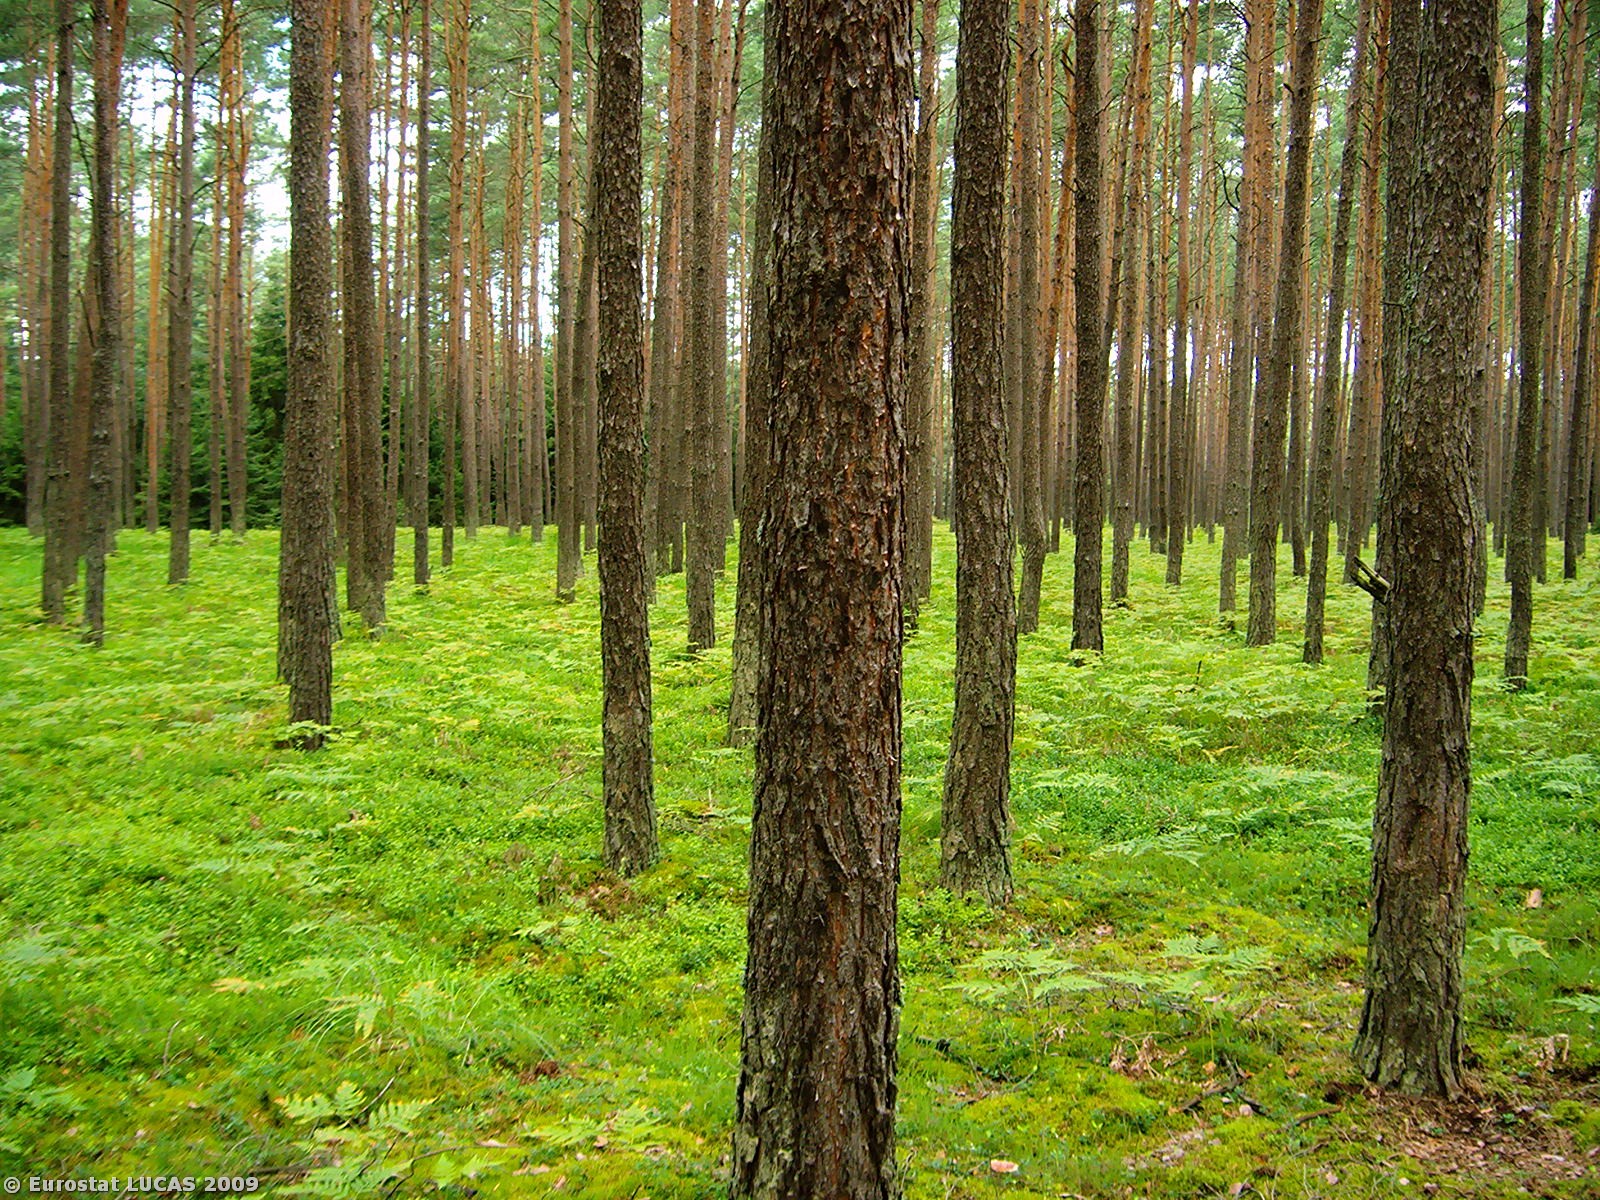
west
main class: Woodland
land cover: Coniferous woodland
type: hemiboreal forest and nemoral coniferous forest and mixed broadleaved-coniferous forest
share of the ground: 50 - 75 %
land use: Forestry
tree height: > 5 m
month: July
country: PL
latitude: 52.7183
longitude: 15.8823
